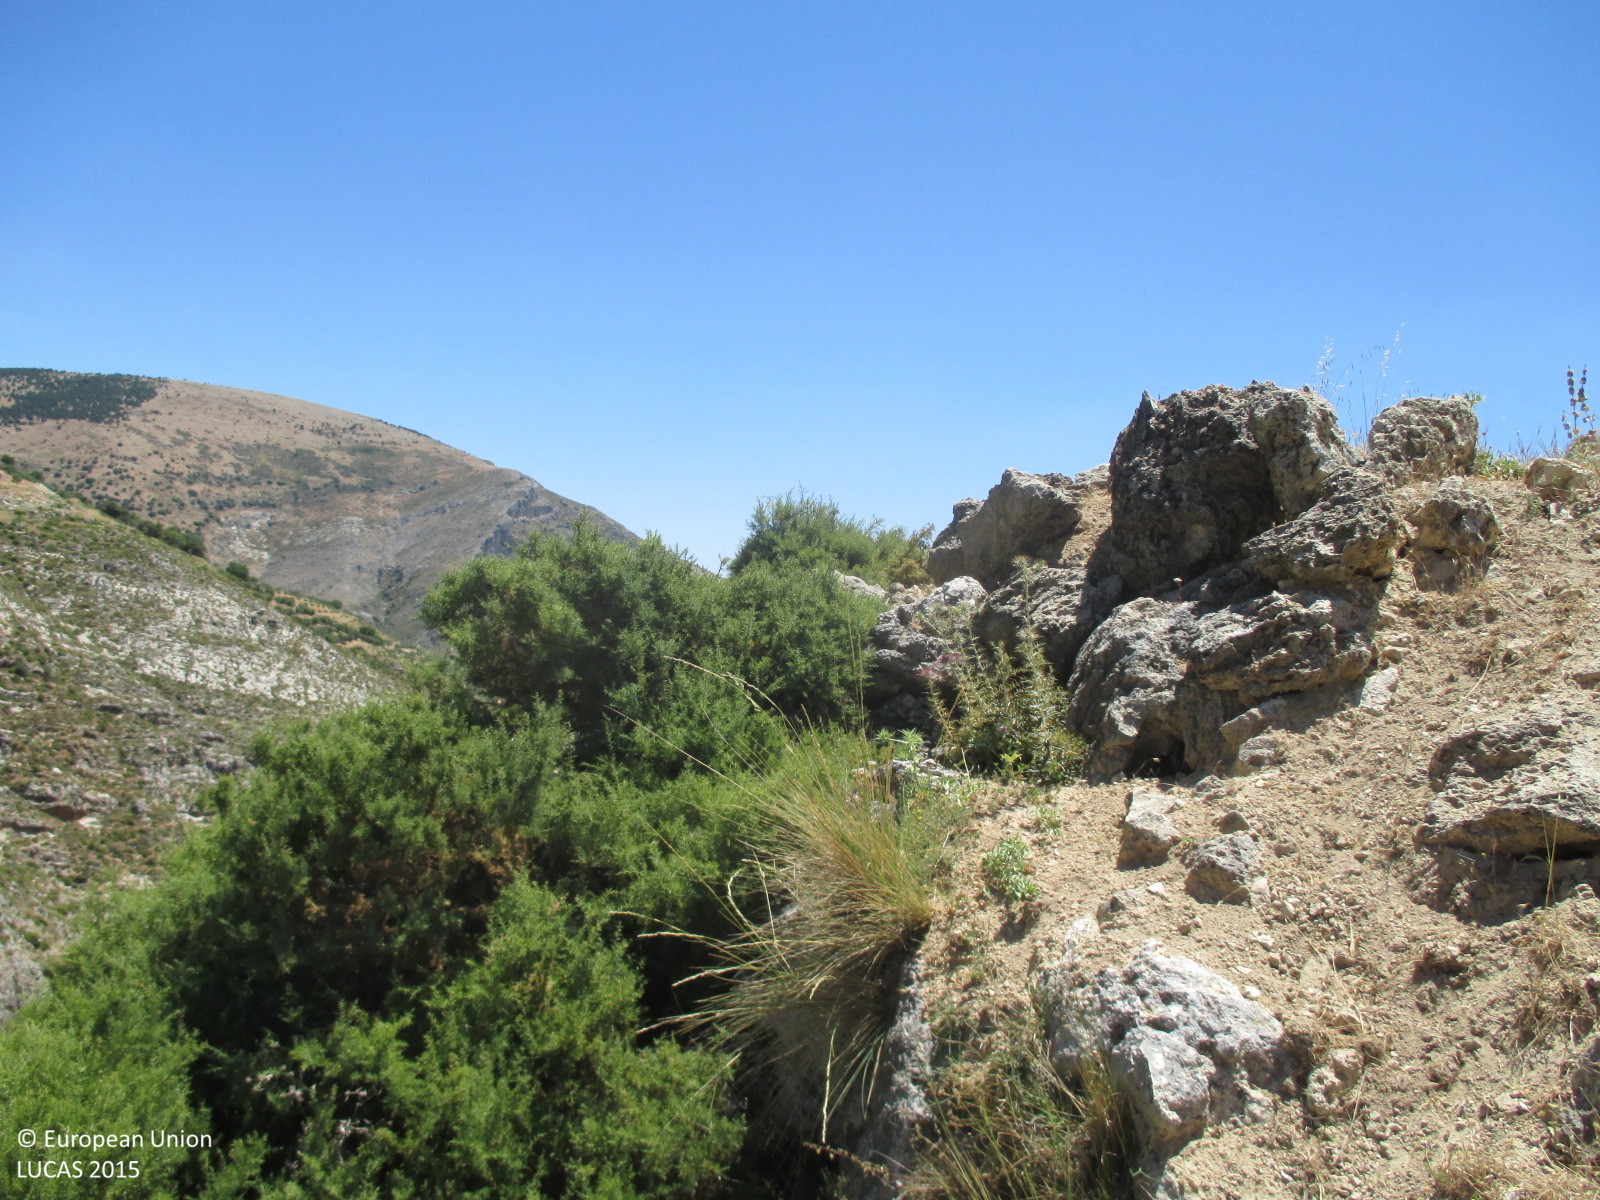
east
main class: Shrubland
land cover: Shrubland without tree cover
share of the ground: > 75 %
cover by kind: shrubs 60 %, herbaceous plants 40 %
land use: Semi-natural and natural areas not in use
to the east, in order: Shrubland without tree cover; Rivers and streams; Shrubland without tree cover; Grassland without tree/shrub cover; Shrubland without tree cover
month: June
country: ES
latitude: 37.4949
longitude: -3.7611
